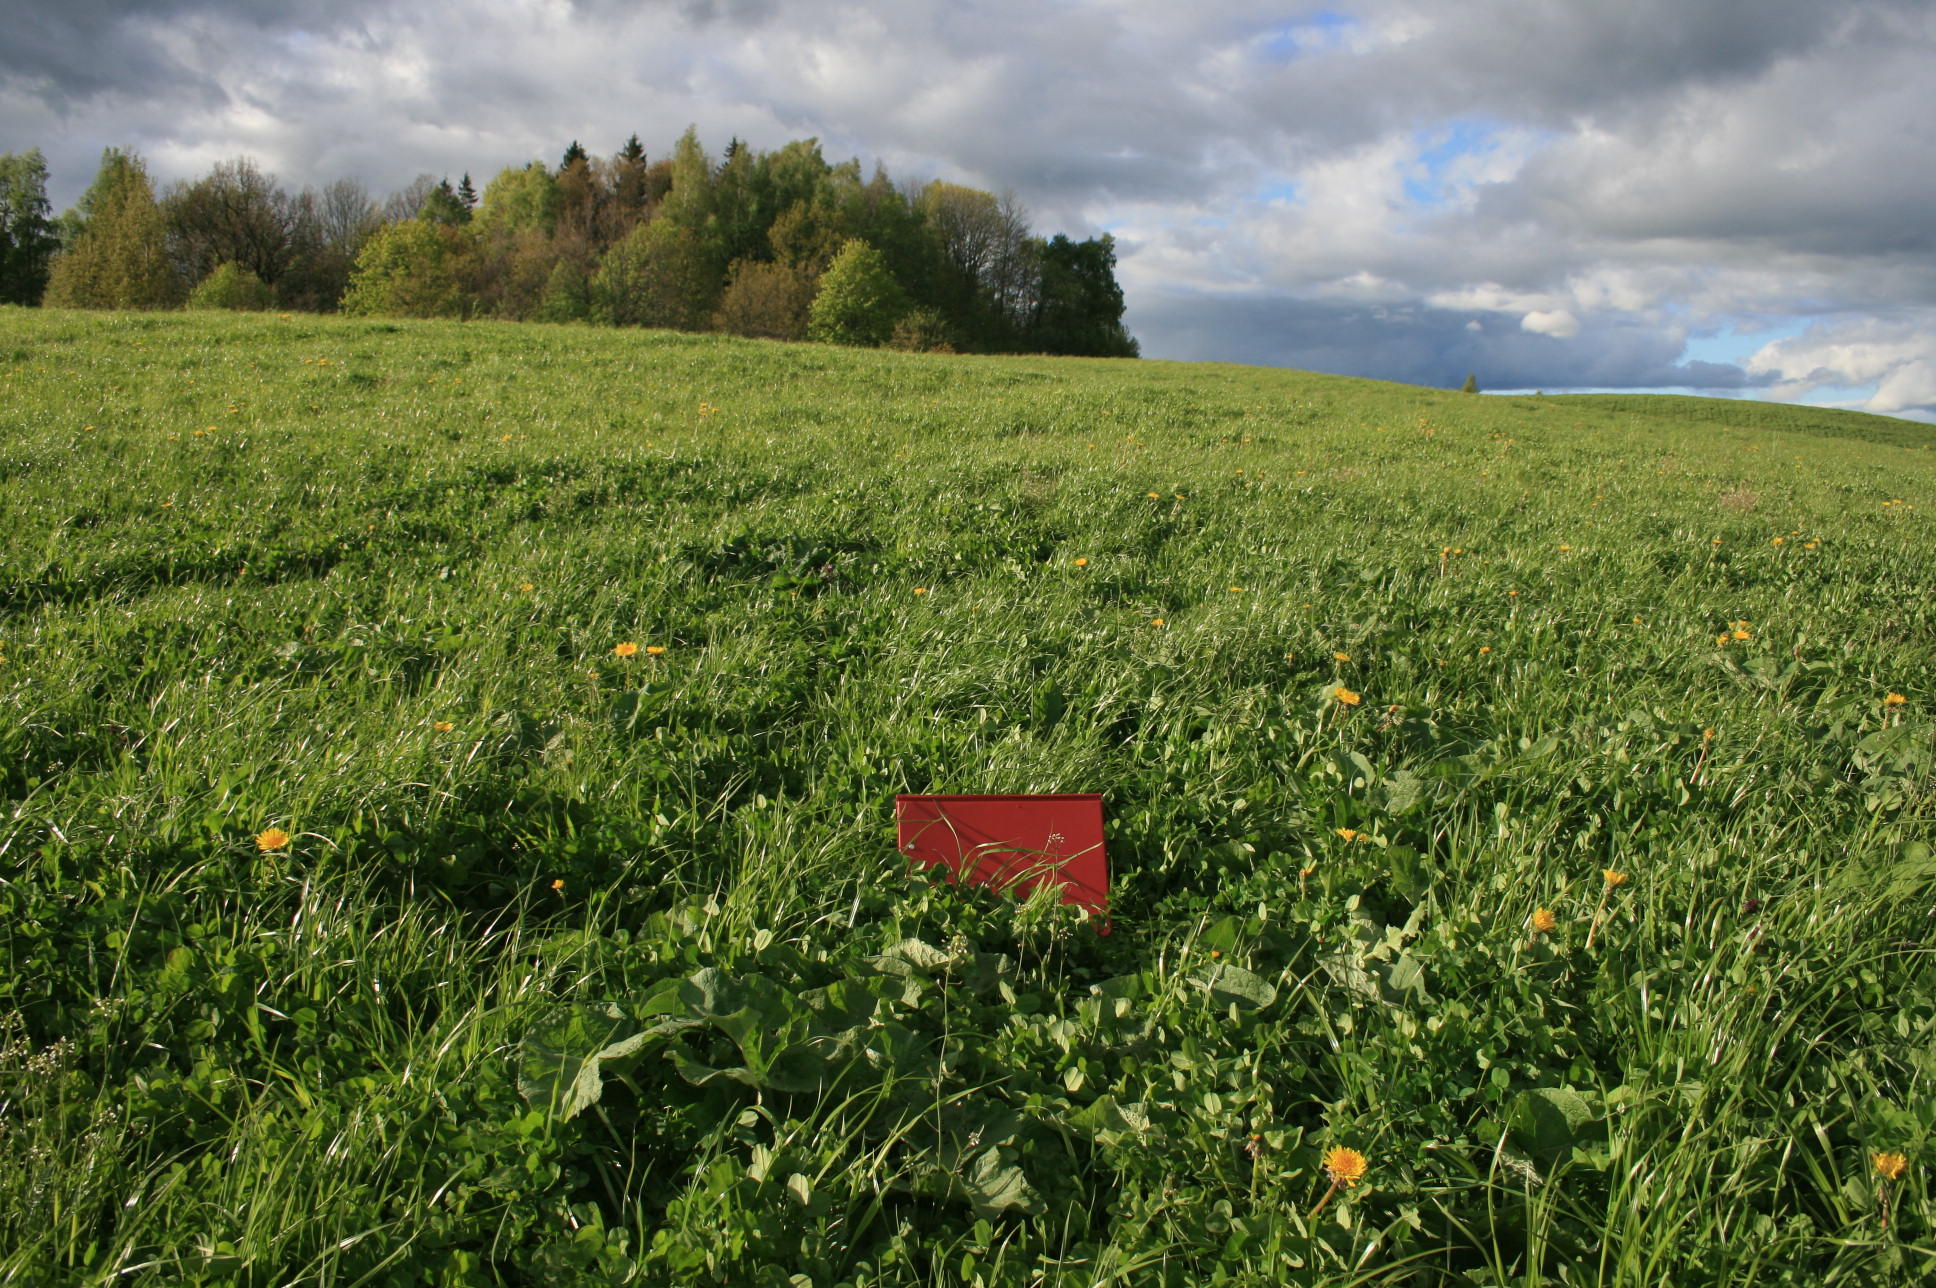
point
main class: Grassland
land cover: Grassland without tree/shrub cover
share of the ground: > 75 %
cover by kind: herbaceous plants 100 %
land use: Agriculture (excluding fallow land and kitchen gardens)
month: May
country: LT
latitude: 56.0576
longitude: 22.0150
